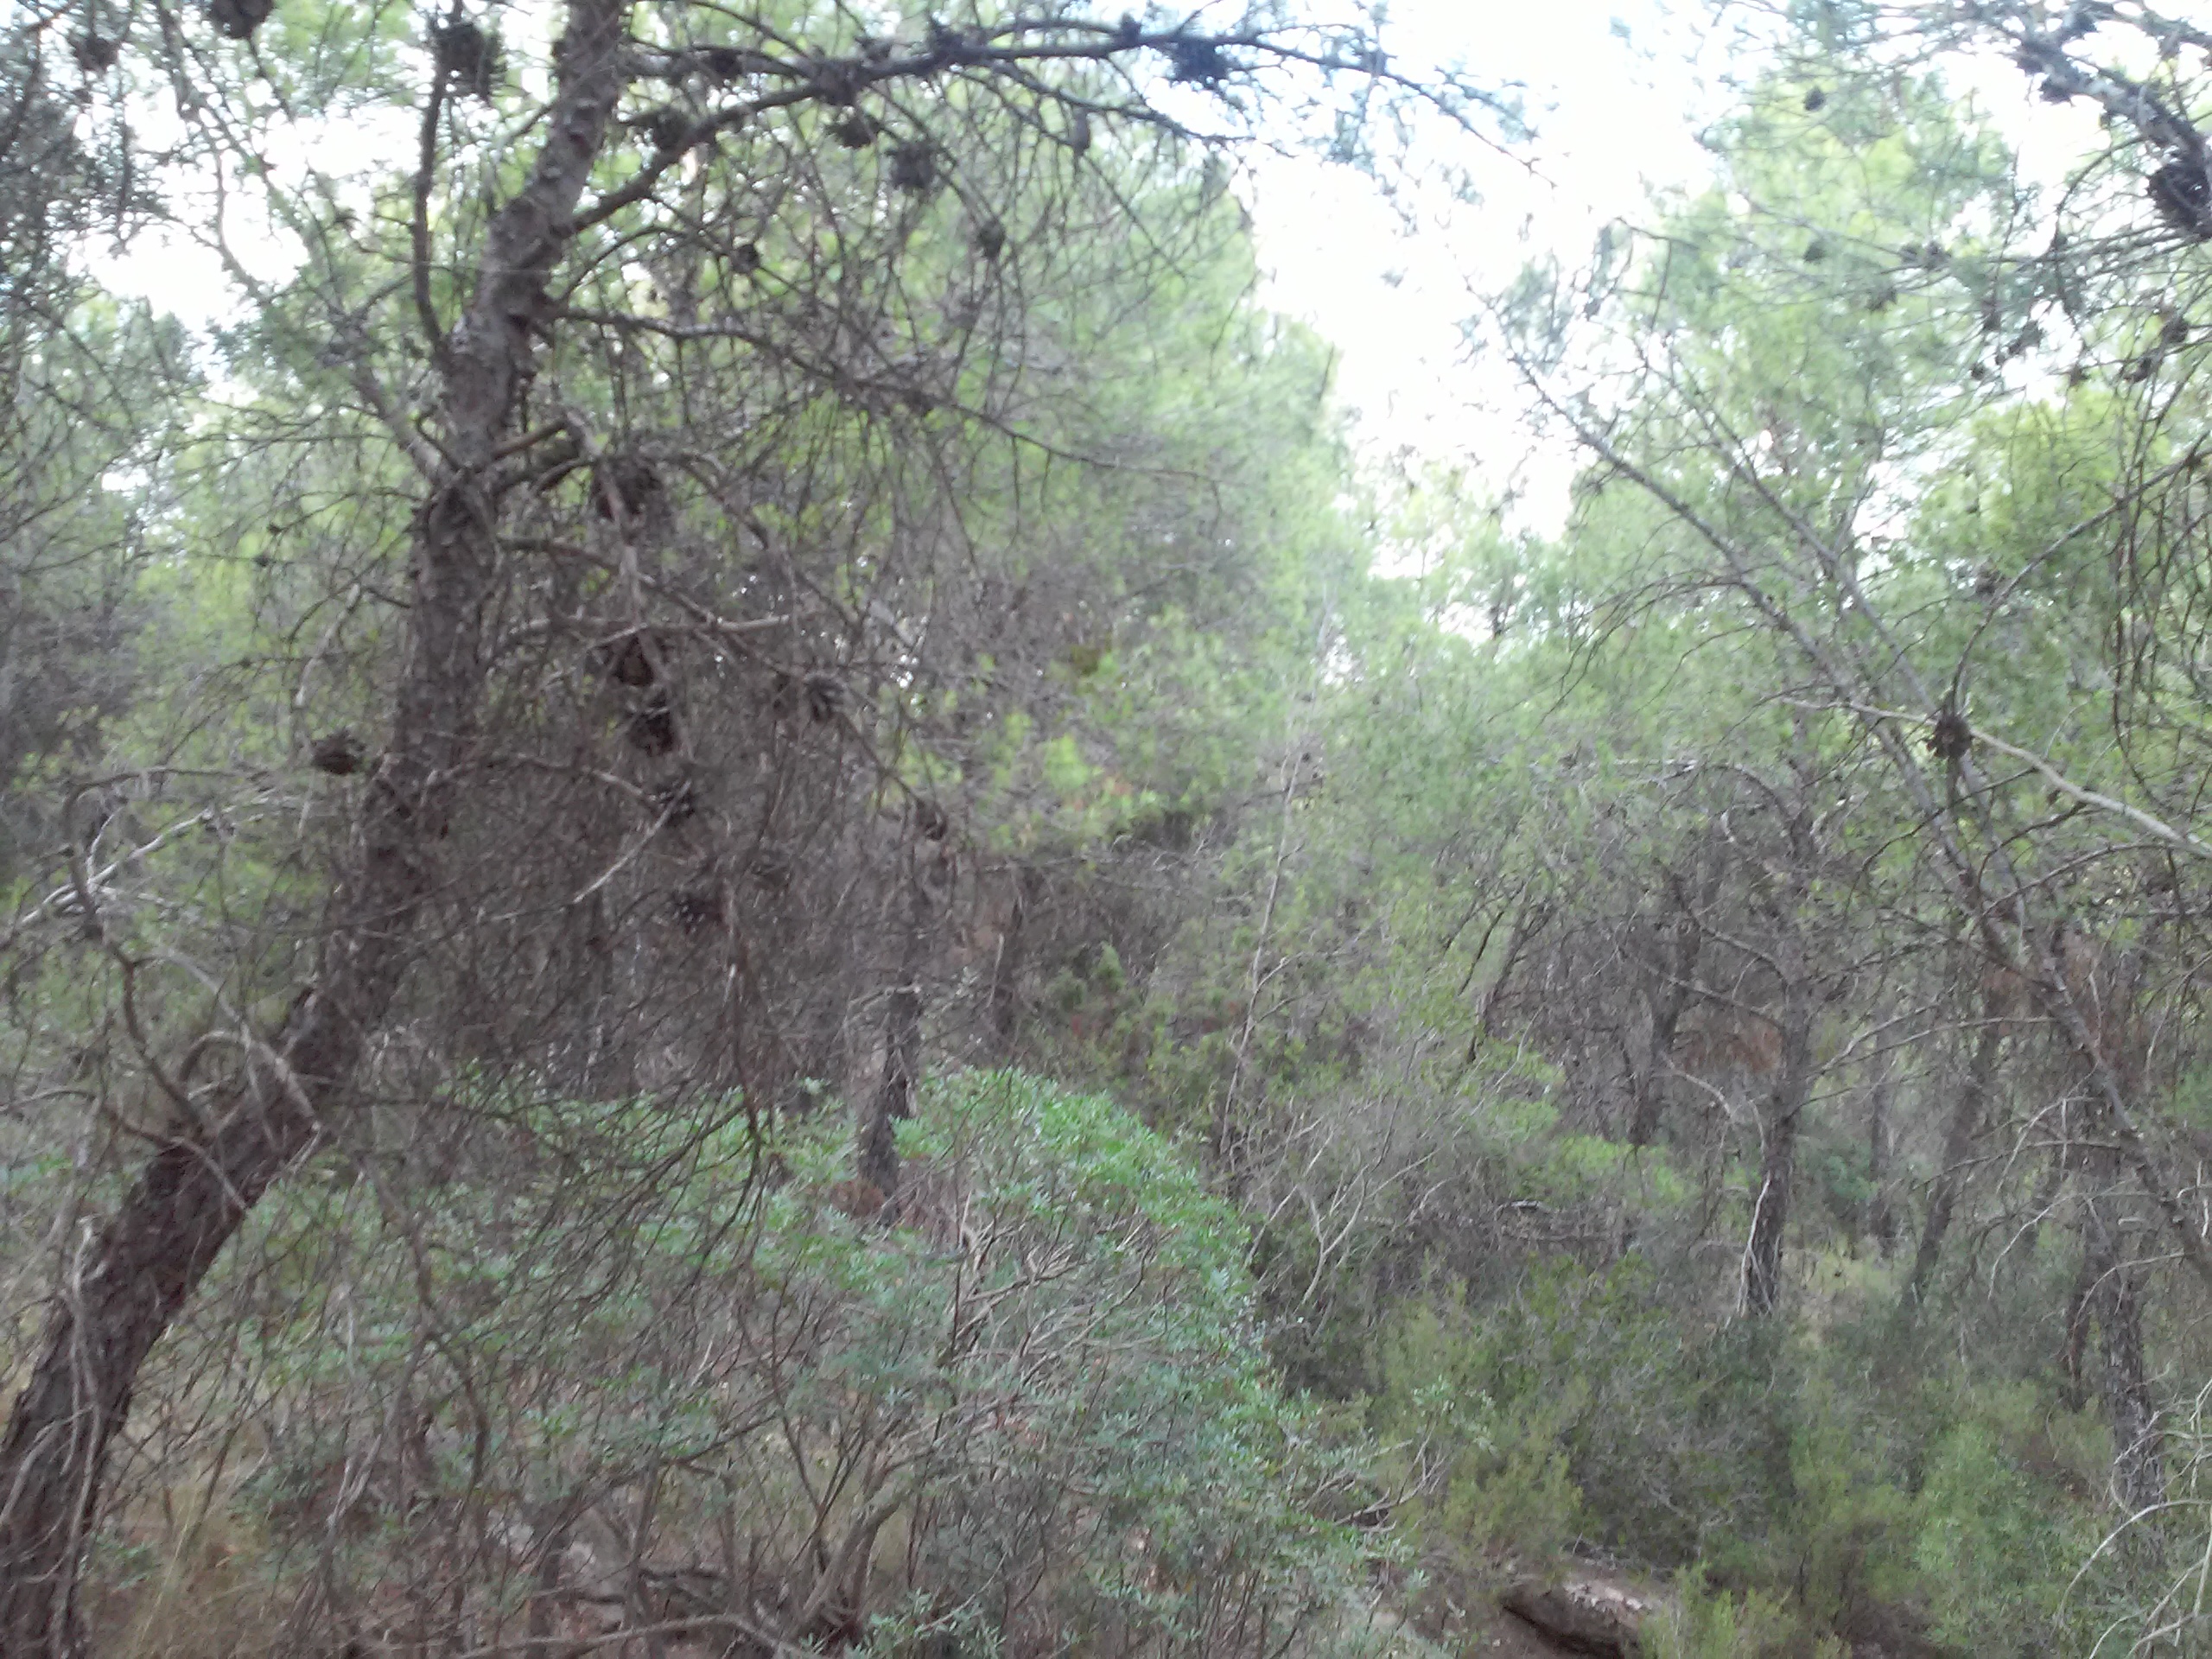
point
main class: Woodland
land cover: Pine dominated coniferous woodland
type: coniferous forest of the mediterranean region
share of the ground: 25 - 50 %
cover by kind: coniferous forest trees 30 %, shrubs 30 %, herbaceous plants 30 %, lichens and mosses 10 %
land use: Semi-natural and natural areas not in use
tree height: < 5 m
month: August
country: ES
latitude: 41.4092
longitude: 0.5263
